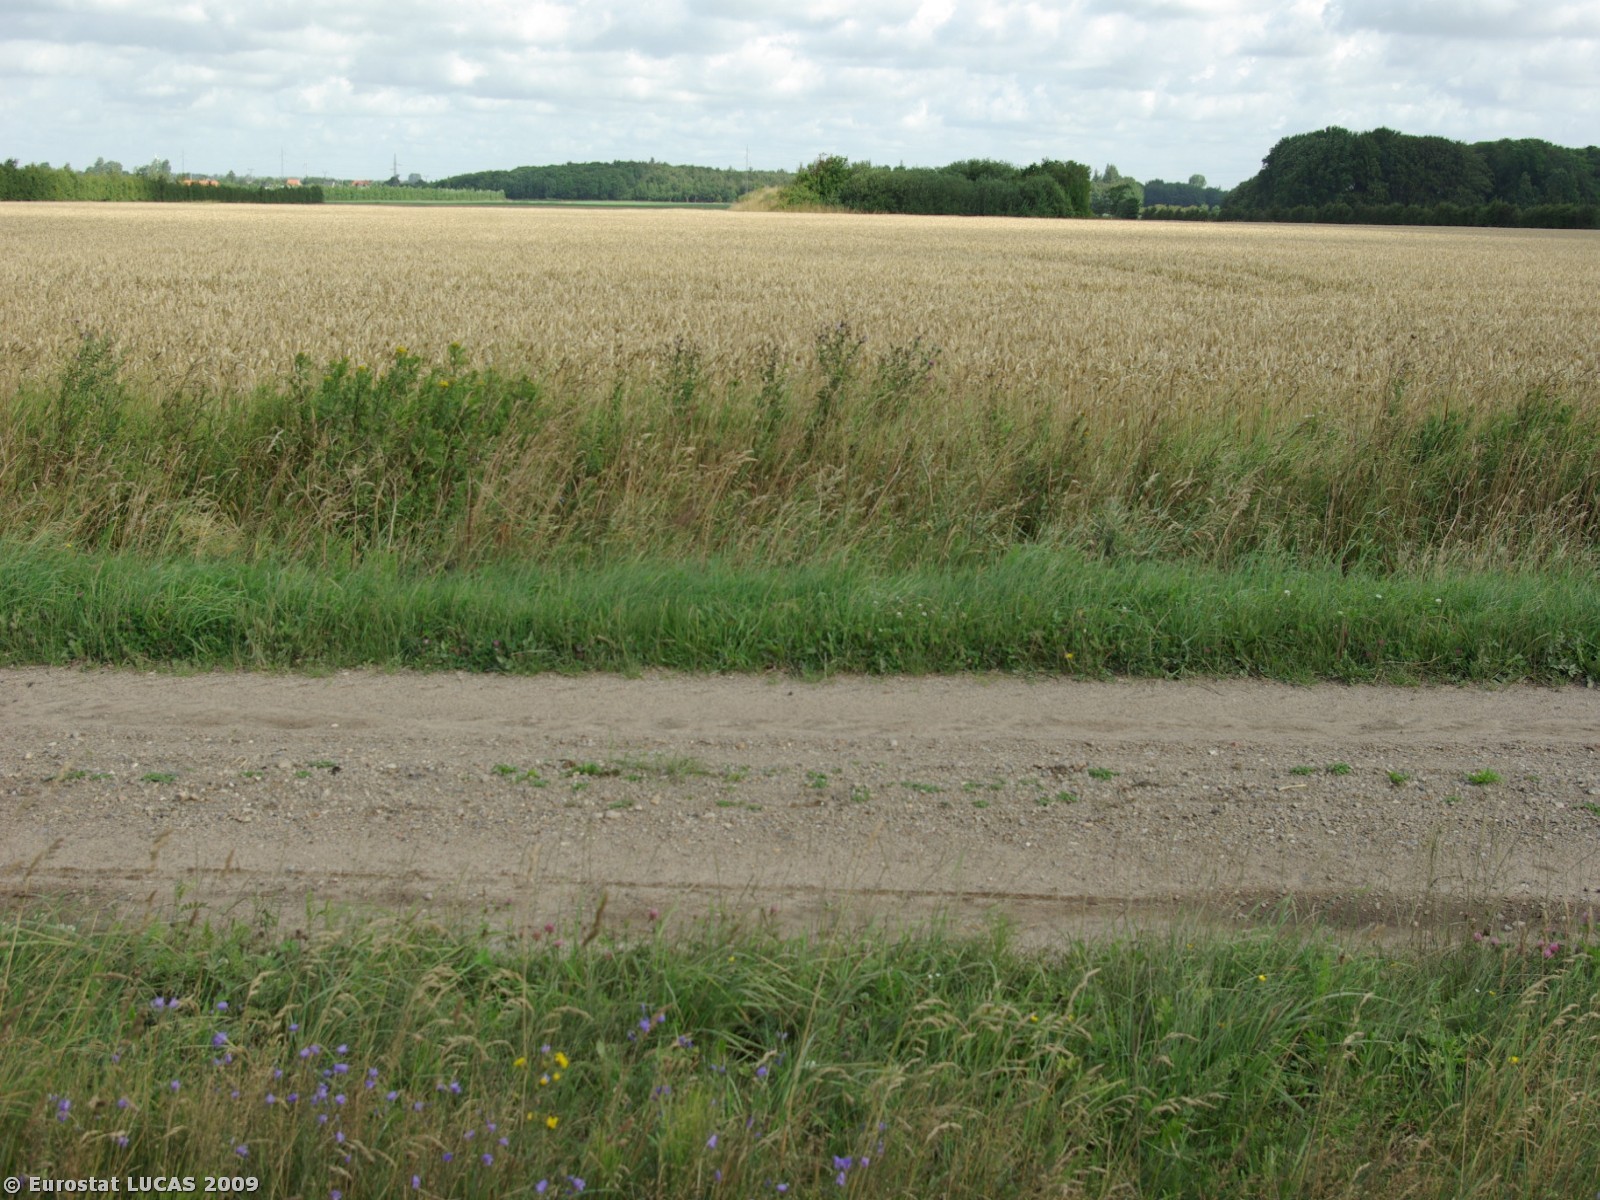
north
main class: Cropland
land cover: Barley
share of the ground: > 75 %
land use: Agriculture (excluding fallow land and kitchen gardens)
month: July
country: DK
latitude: 54.9957
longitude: 8.7973
